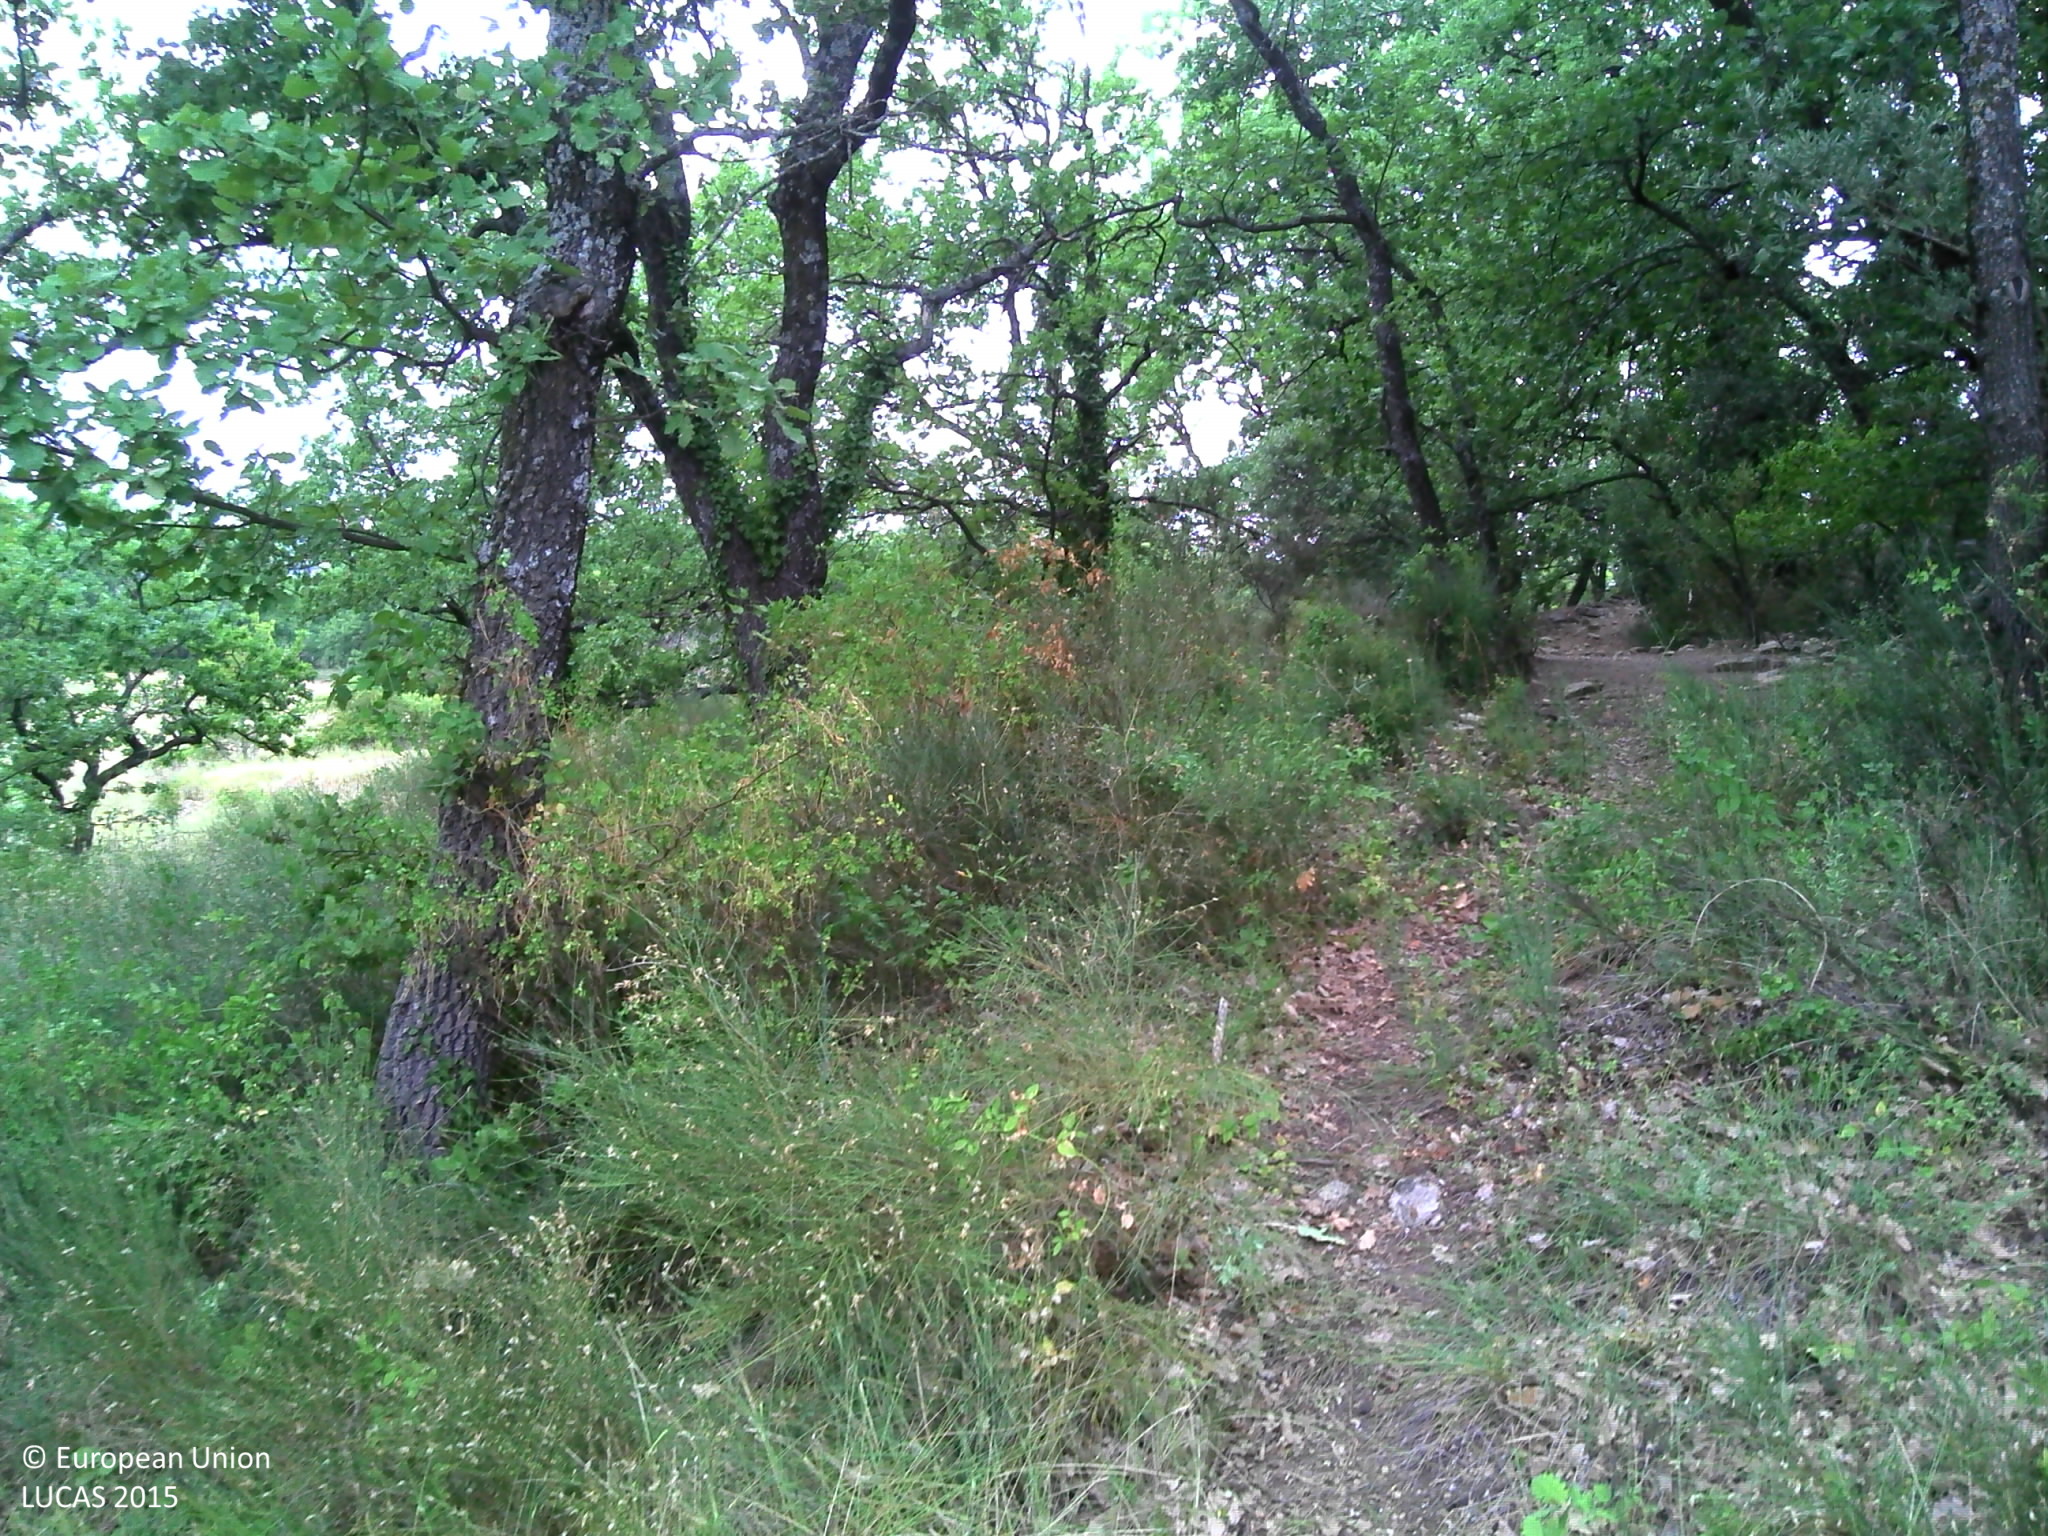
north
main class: Woodland
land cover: Broadleaved woodland
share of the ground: < 10 %
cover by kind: herbaceous plants 90 %, broadleaved forest trees 10 %
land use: Forestry
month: August
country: FR
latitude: 43.8700
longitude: 5.4170
